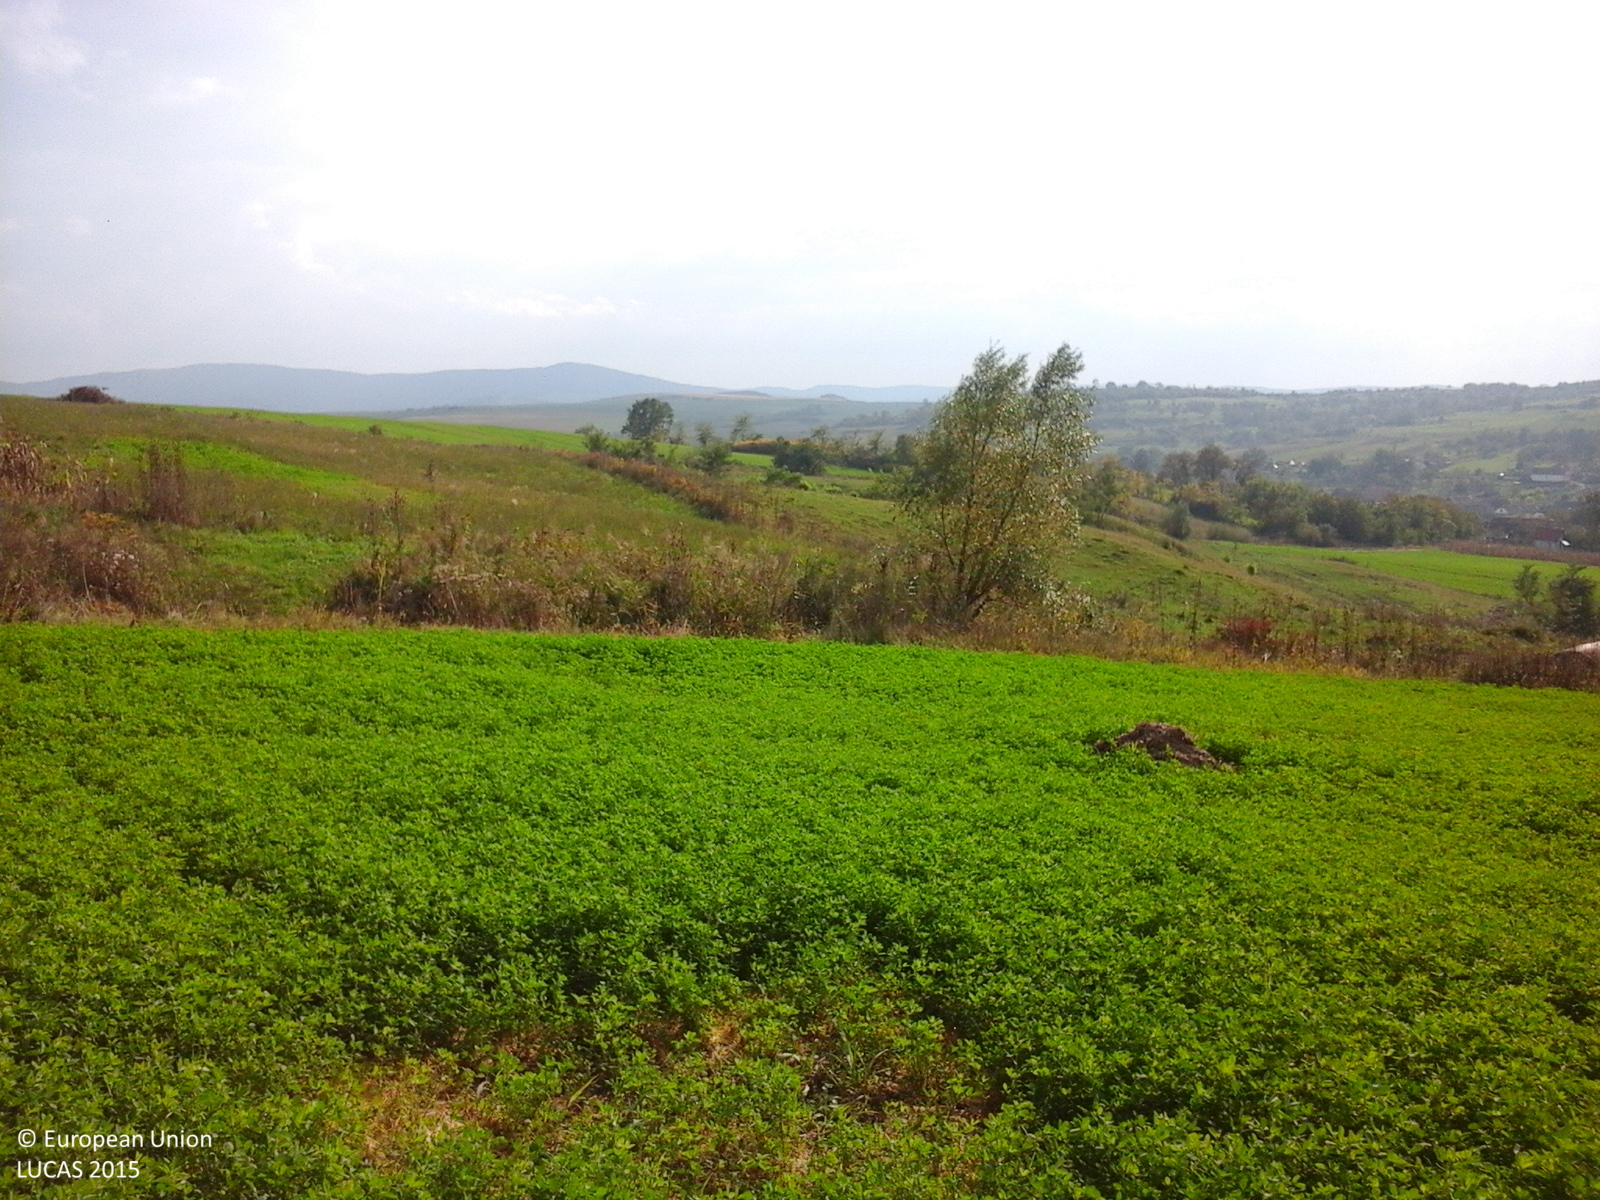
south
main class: Cropland
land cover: Lucerne
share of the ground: > 75 %
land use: Agriculture (excluding fallow land and kitchen gardens)
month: October
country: RO
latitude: 46.2458
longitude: 24.2828
